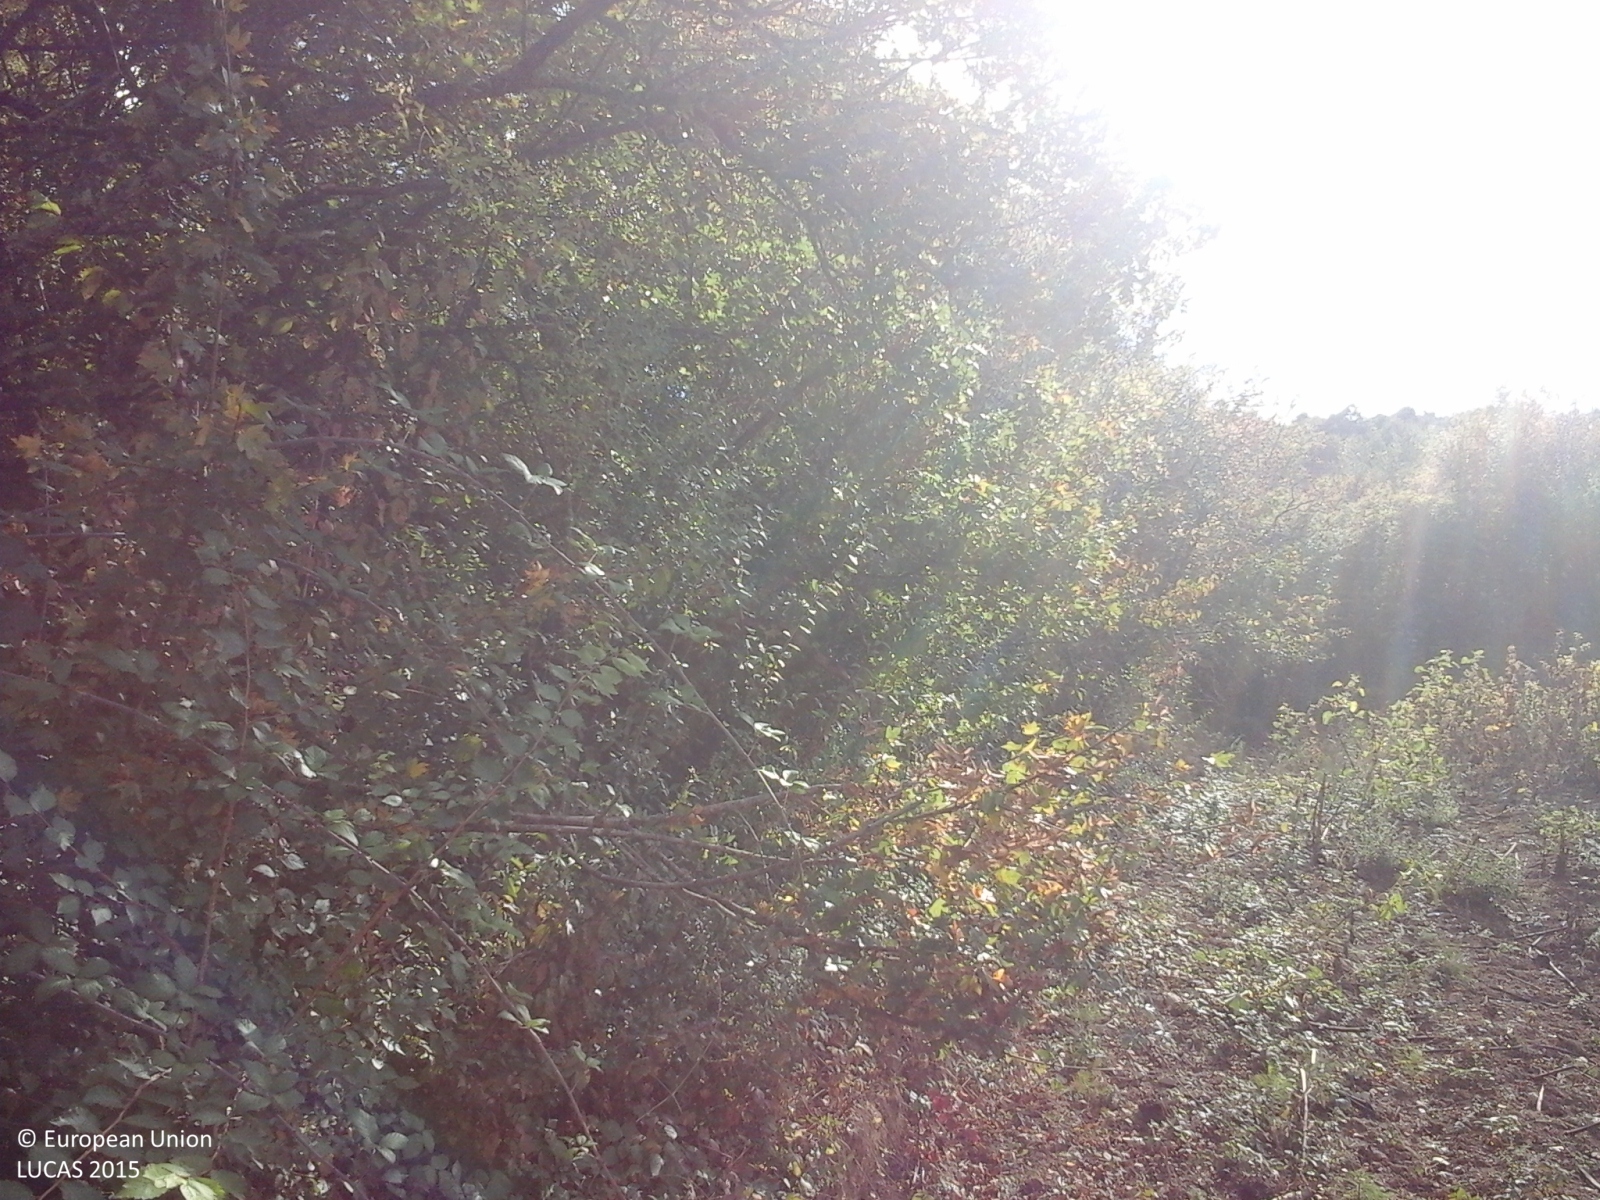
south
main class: Cropland
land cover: Sunflower
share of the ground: < 10 %
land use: Agriculture (excluding fallow land and kitchen gardens)
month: October
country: IT
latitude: 43.3148
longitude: 12.2747
